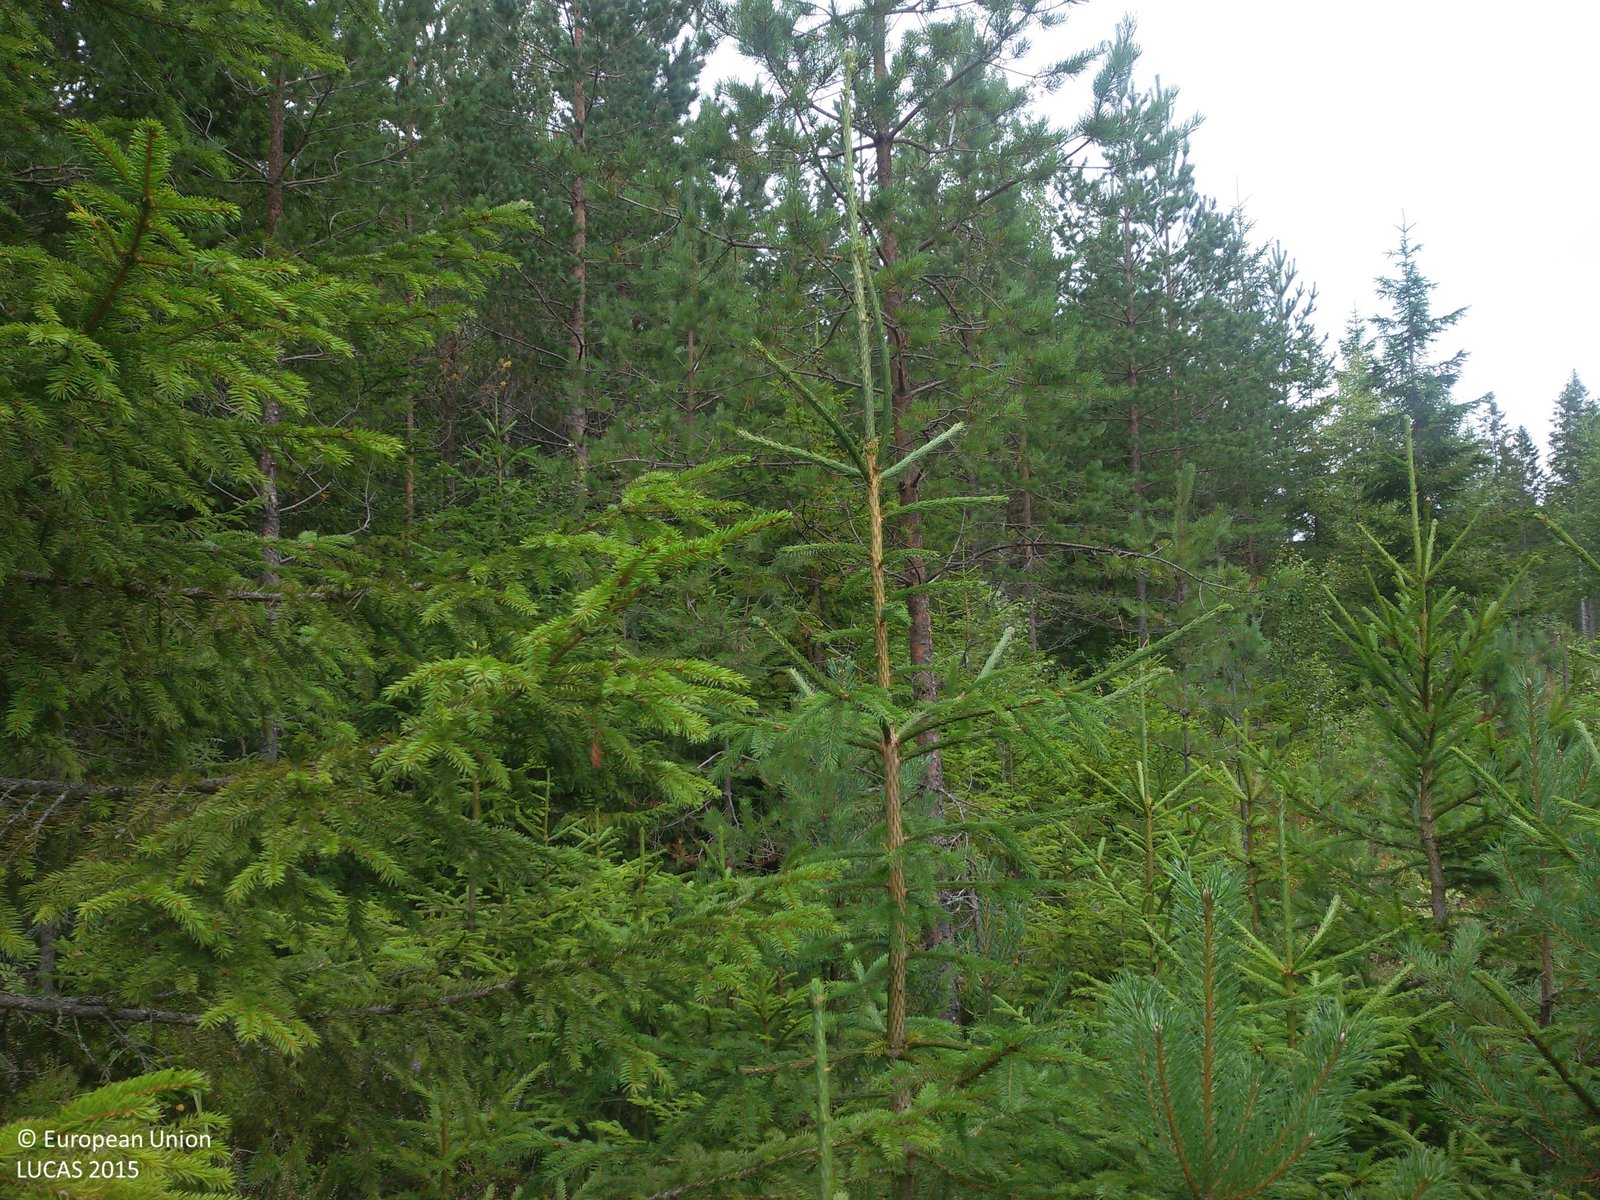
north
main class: Woodland
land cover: Other coniferous woodland
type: boreal forest
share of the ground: > 75 %
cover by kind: coniferous forest trees 65 %, herbaceous plants 20 %, broadleaved forest trees 15 %
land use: Forestry
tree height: < 5 m
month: August
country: SE
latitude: 60.8562
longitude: 16.6324
